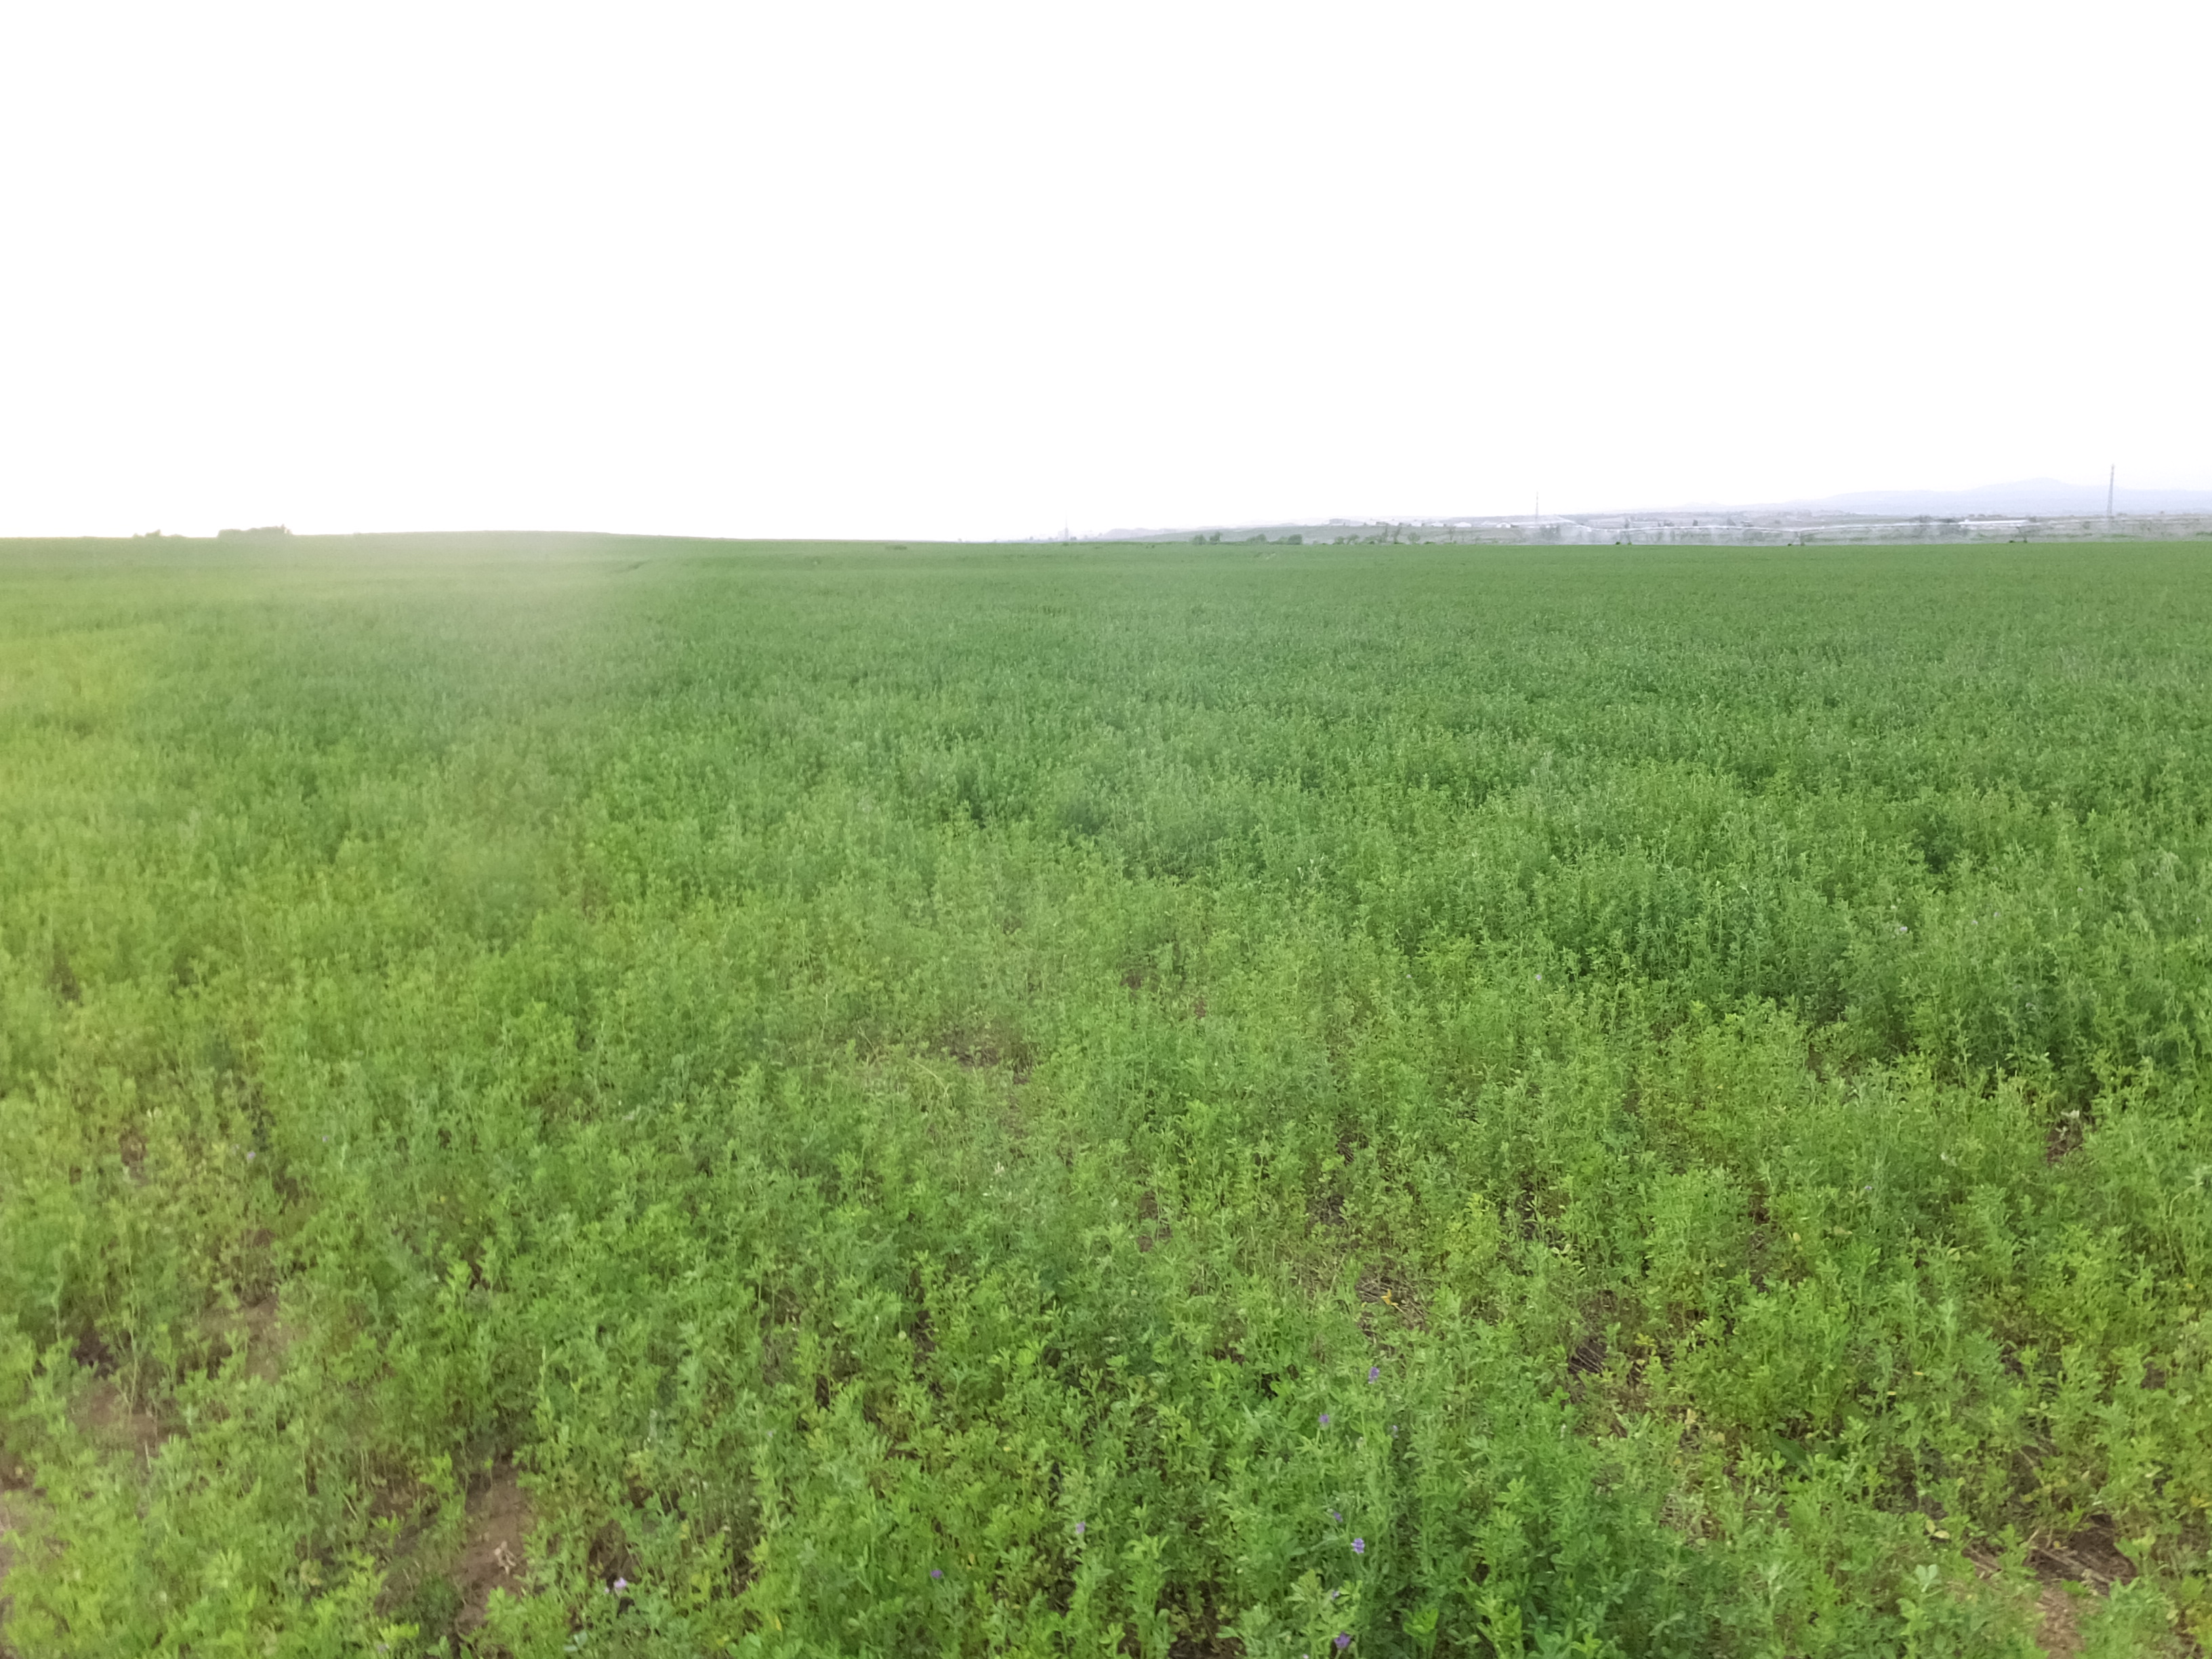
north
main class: Cropland
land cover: Lucerne
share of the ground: > 75 %
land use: Agriculture (excluding fallow land and kitchen gardens)
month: July
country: ES
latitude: 41.7717
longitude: 0.3250
